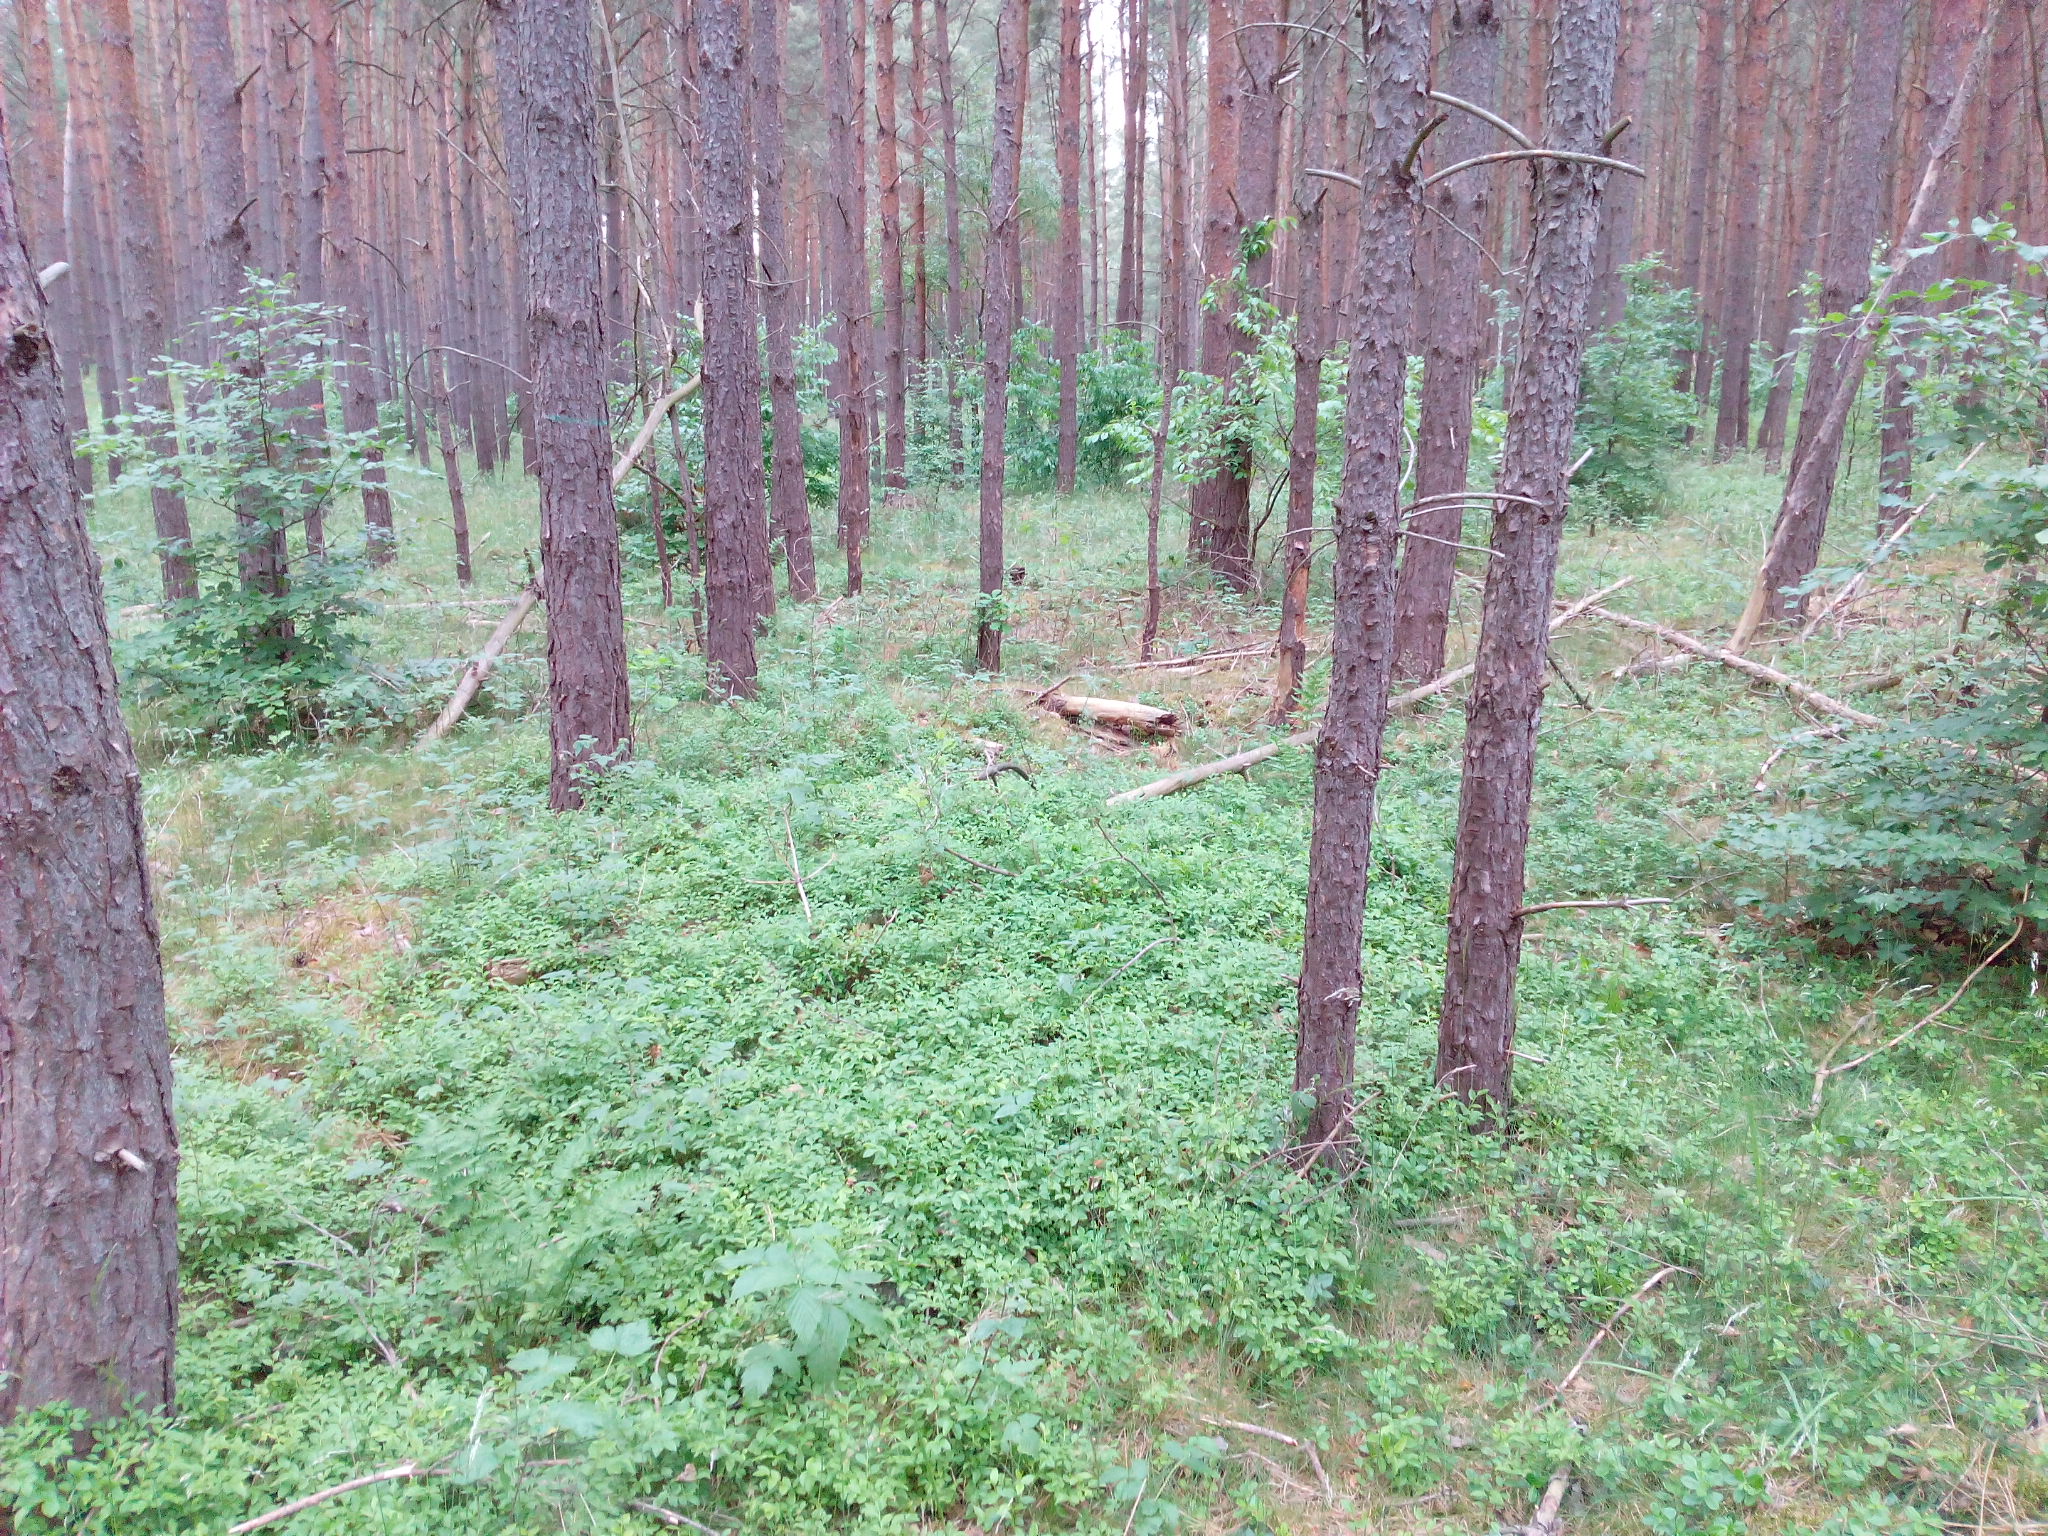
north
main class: Woodland
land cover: Pine dominated coniferous woodland
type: hemiboreal forest and nemoral coniferous forest and mixed broadleaved-coniferous forest
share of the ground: 50 - 75 %
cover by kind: coniferous forest trees 60 %, herbaceous plants 15 %, lichens and mosses 15 %, shrubs 10 %
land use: Forestry
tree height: > 5 m
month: June
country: DE
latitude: 53.0078
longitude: 13.5620
